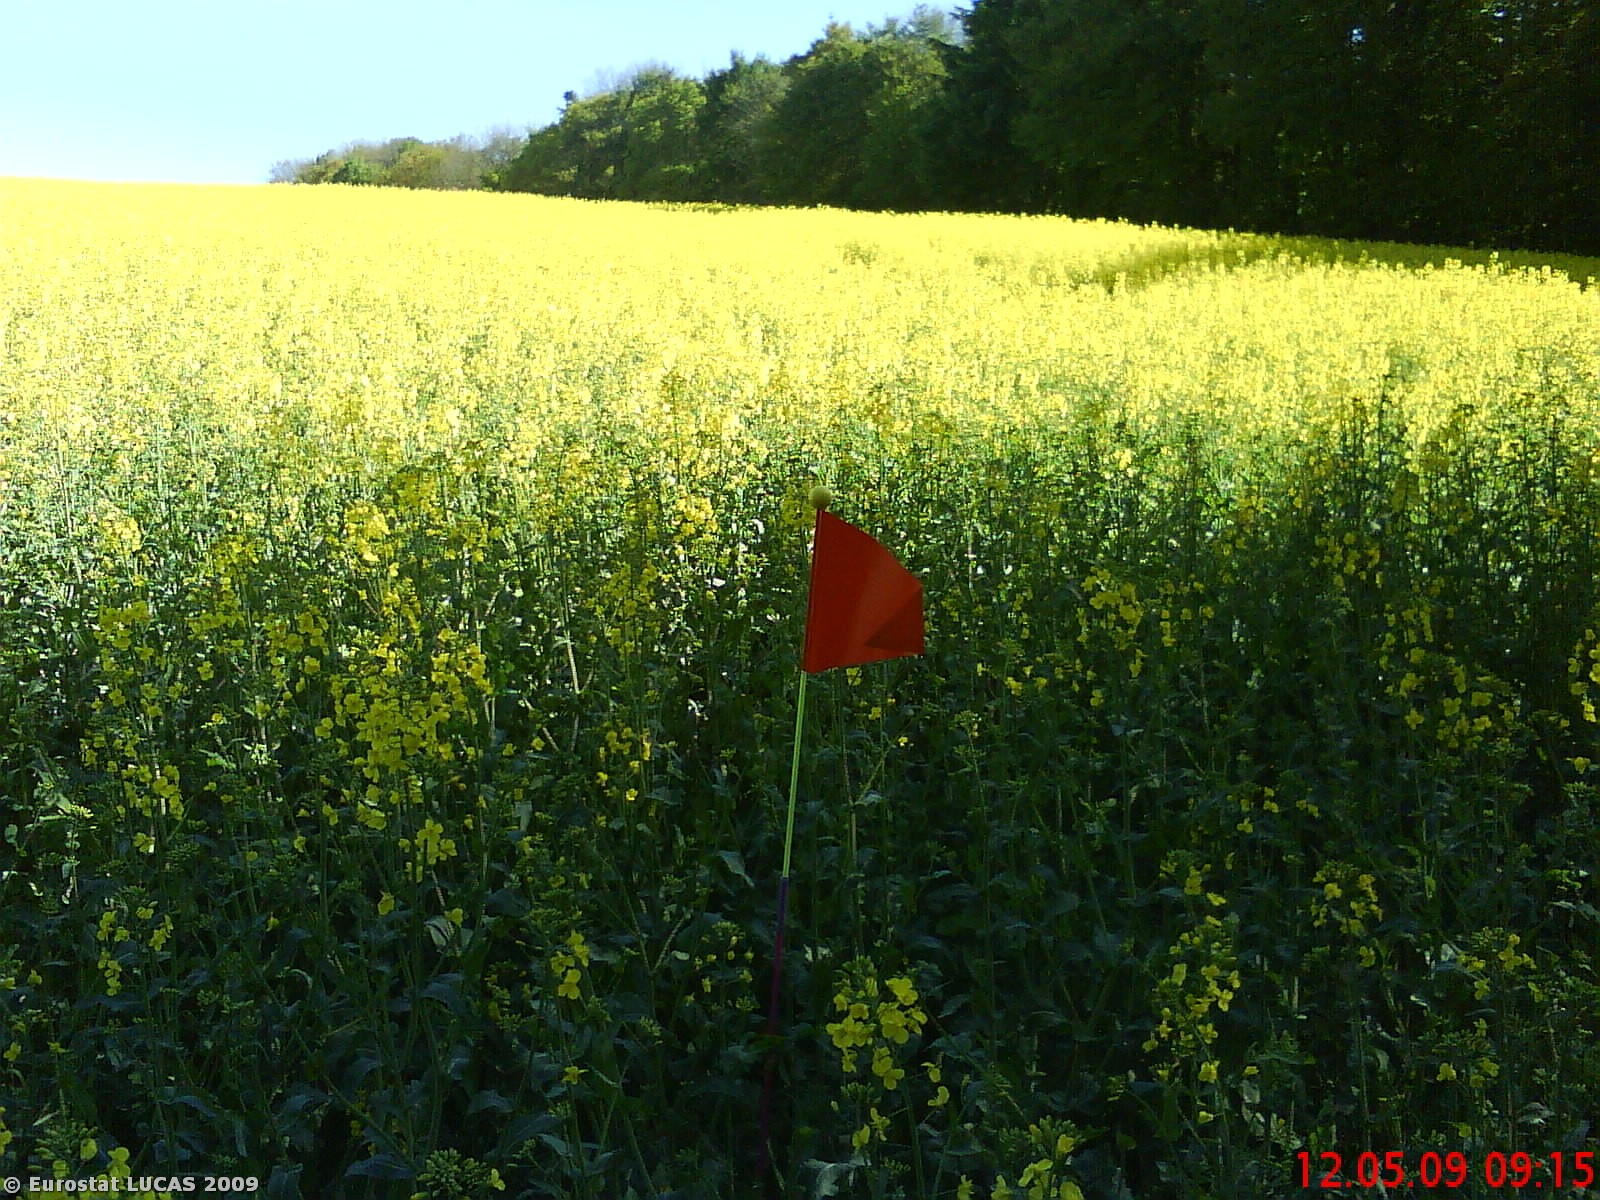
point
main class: Cropland
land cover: Rape and turnip rape
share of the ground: > 75 %
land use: Agriculture (excluding fallow land and kitchen gardens)
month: May
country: DK
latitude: 56.3291
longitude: 10.7915
